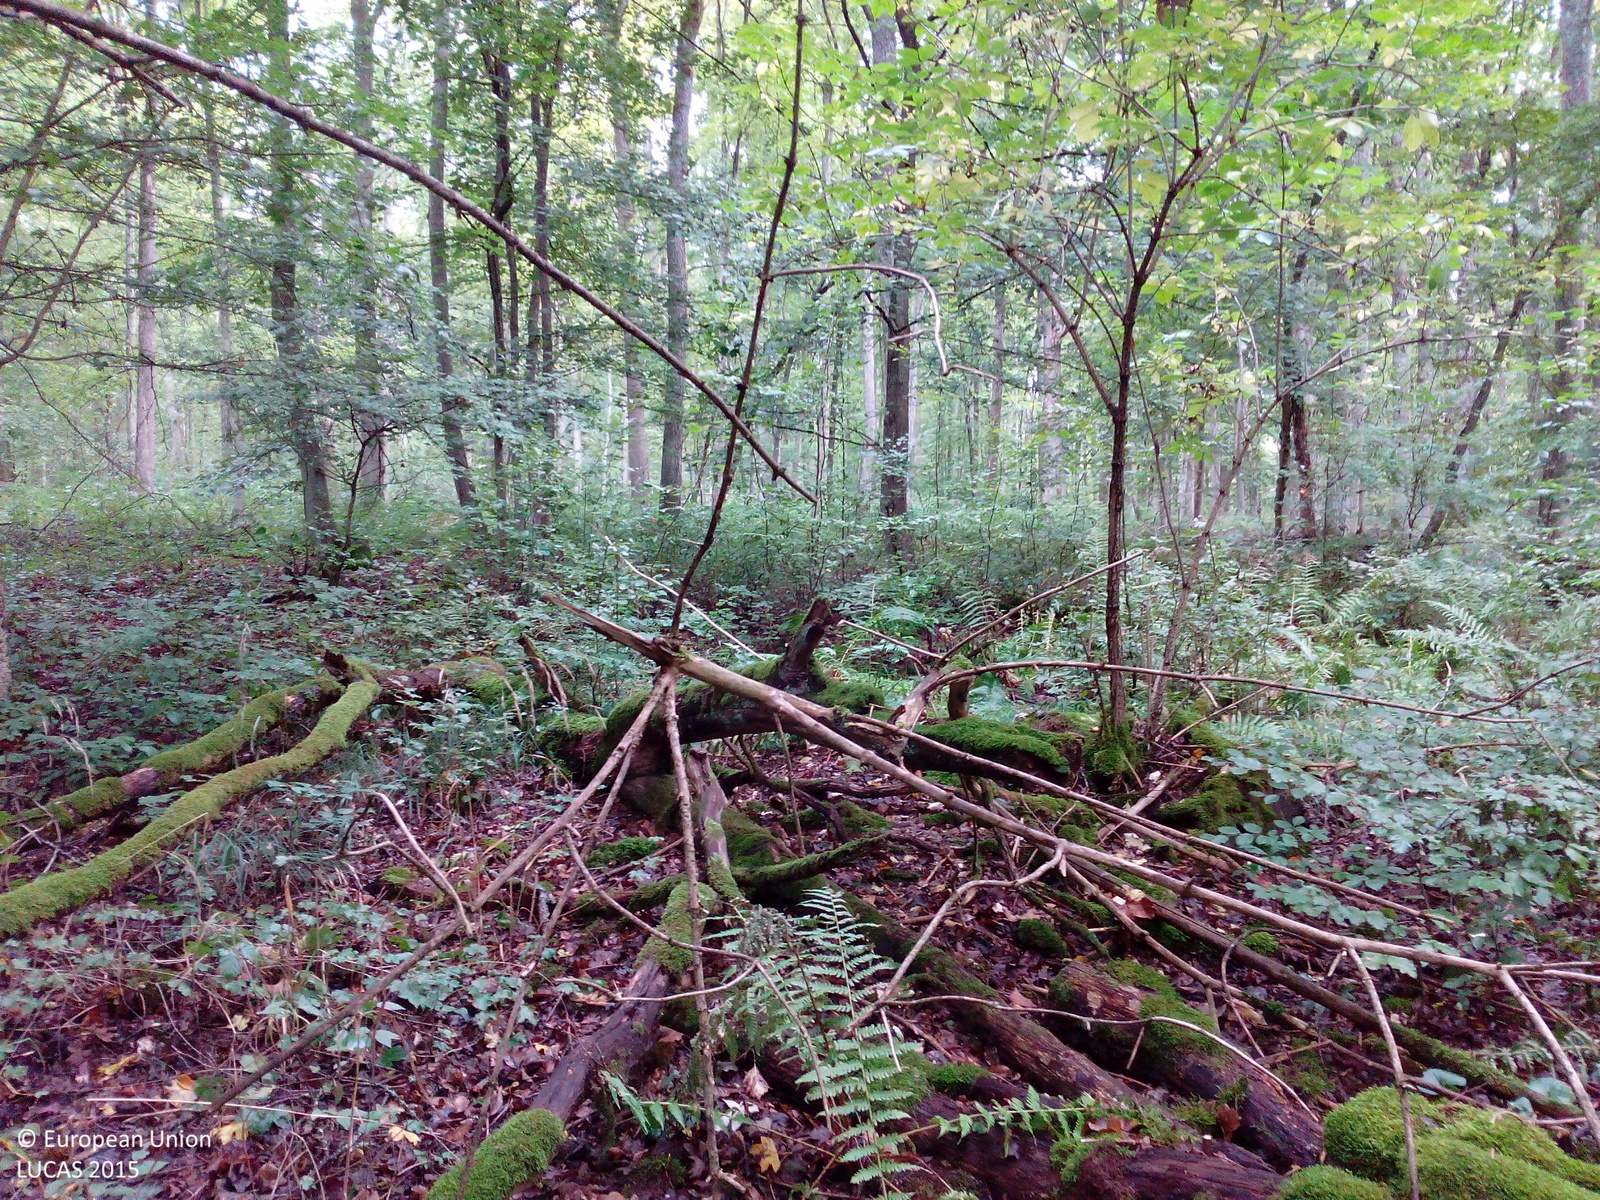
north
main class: Woodland
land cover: Broadleaved woodland
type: acidophilous oak and oak-birch forest
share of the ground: > 75 %
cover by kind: broadleaved forest trees 90 %, shrubs 5 %, unconsolidated bare surface 5 %
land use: Forestry
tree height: > 5 m
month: September
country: DE
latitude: 50.0044
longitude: 9.9024
